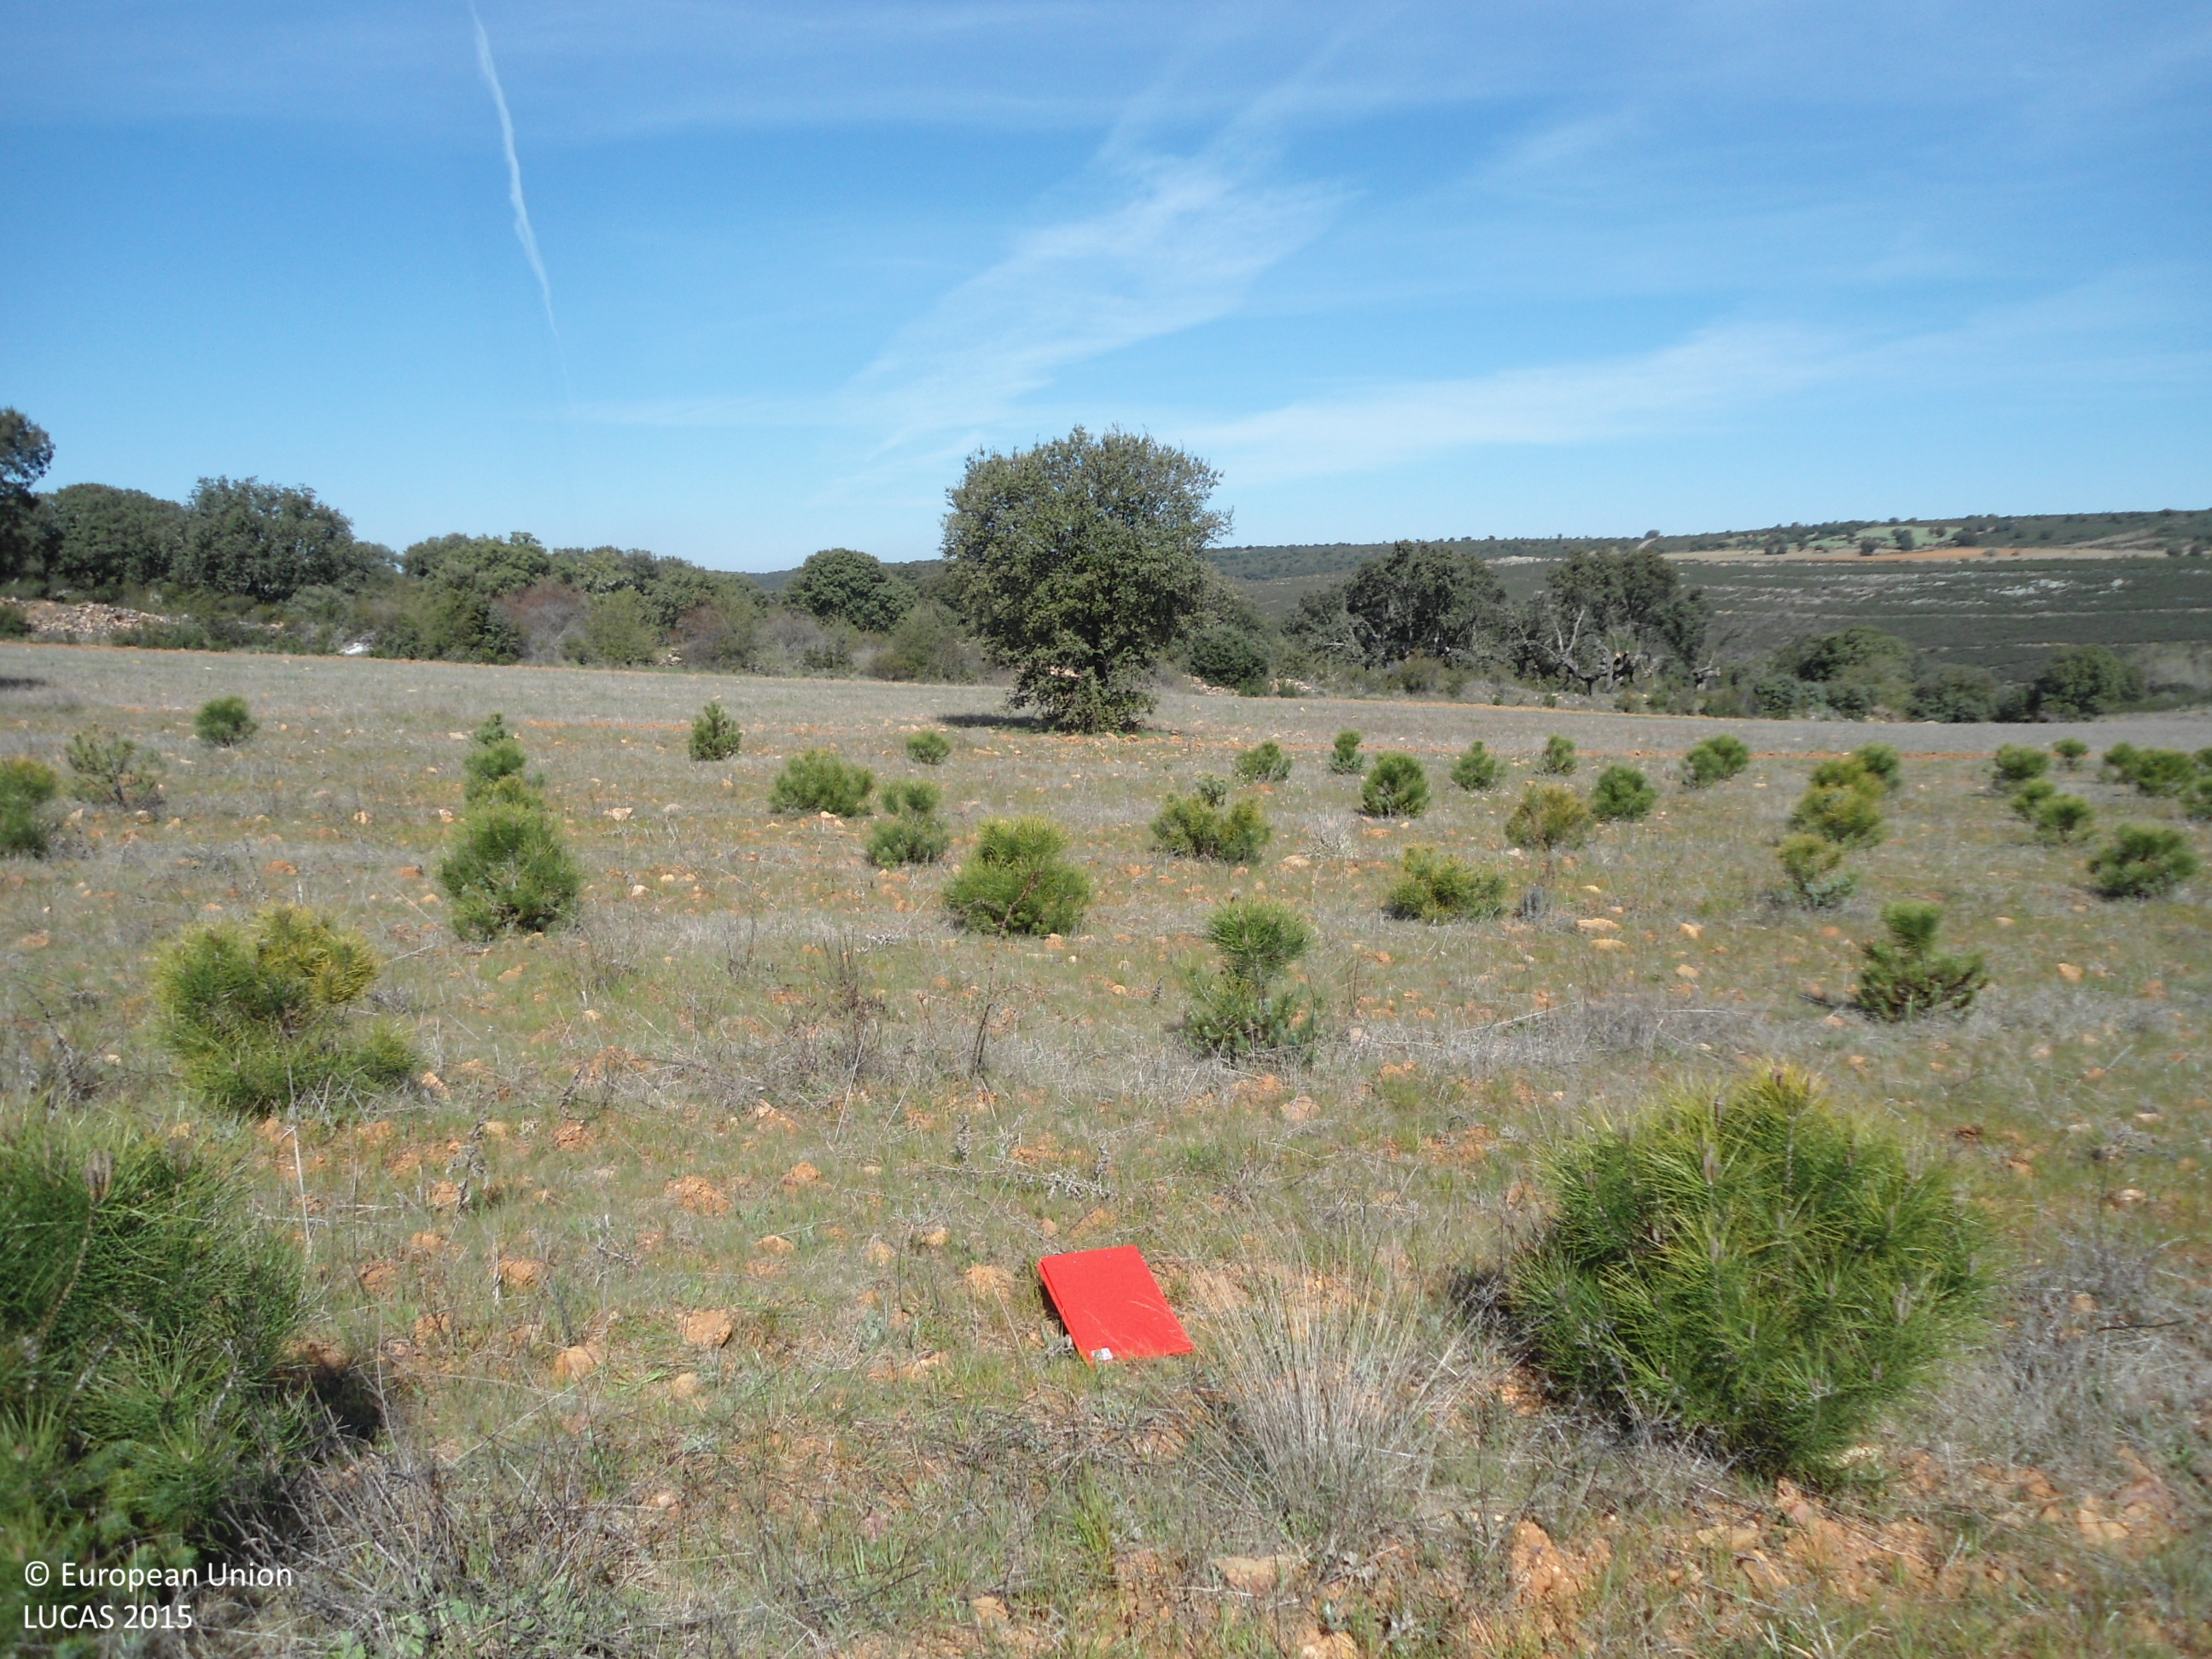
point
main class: Woodland
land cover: Pine dominated coniferous woodland
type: coniferous forest of the mediterranean region
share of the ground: 25 - 50 %
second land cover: Spontaneously vegetated surfaces
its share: 25 - 50 %
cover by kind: herbaceous plants 55 %, coniferous forest trees 45 %
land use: Forestry
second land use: Fallow land
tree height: < 5 m
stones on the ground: < 10 %
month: April
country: ES
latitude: 41.7057
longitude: -5.8709
